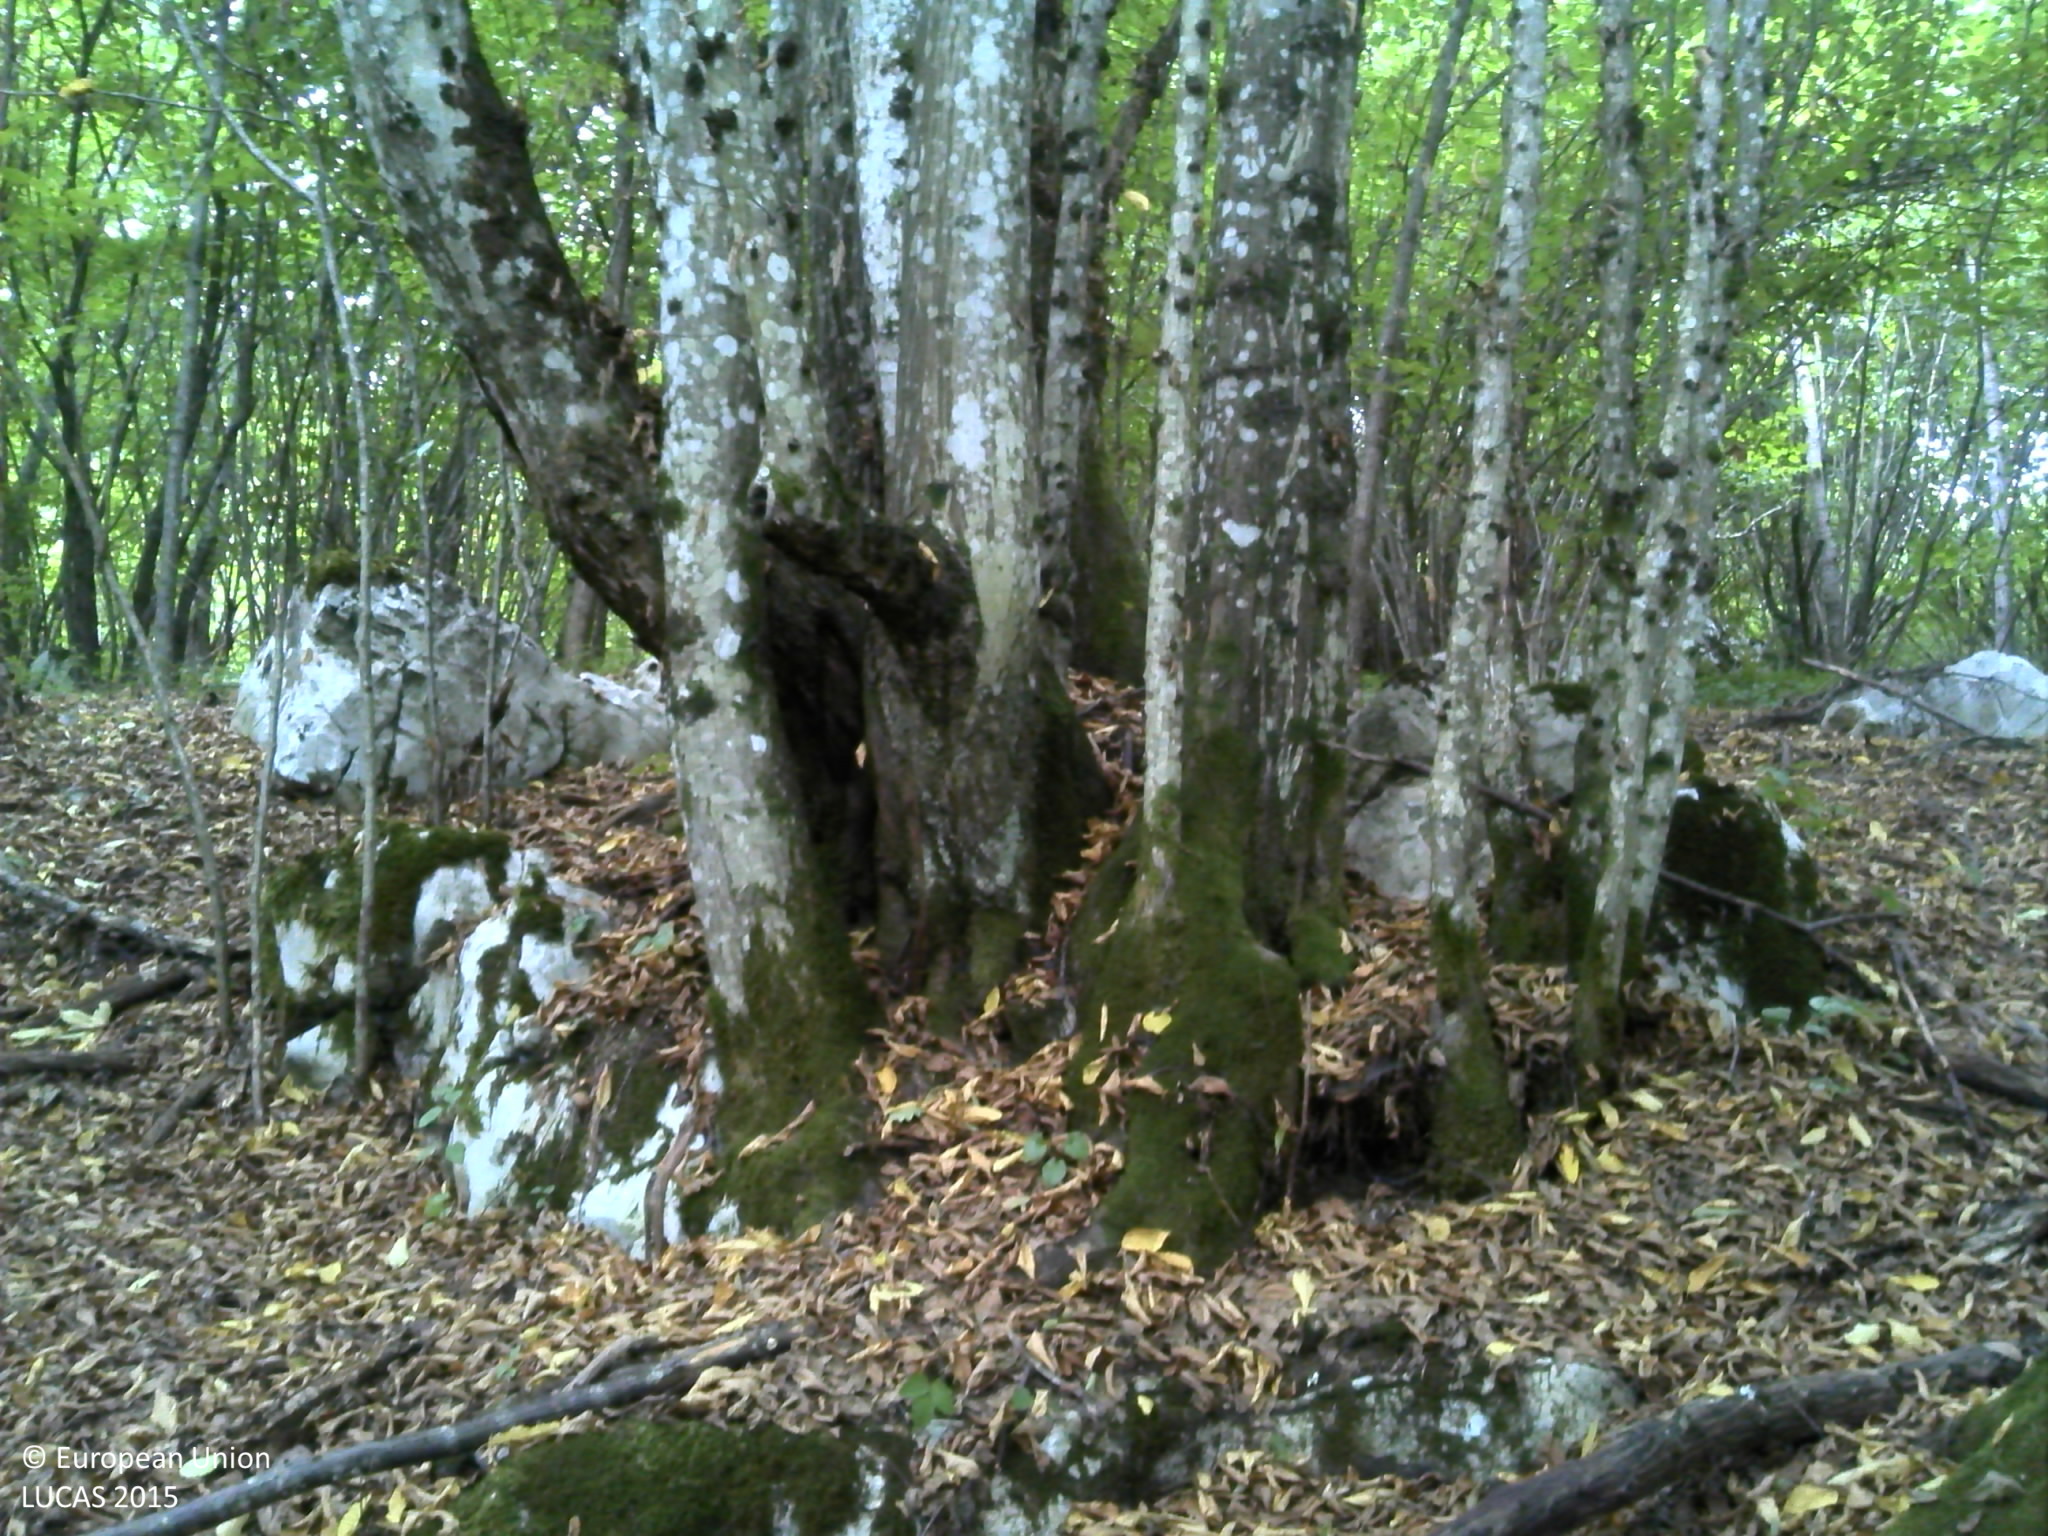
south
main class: Woodland
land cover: Broadleaved woodland
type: acidophilous oak and oak-birch forest
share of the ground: > 75 %
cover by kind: broadleaved forest trees 100 %
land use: Forestry
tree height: > 5 m
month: September
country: HR
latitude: 45.4075
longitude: 15.2981
